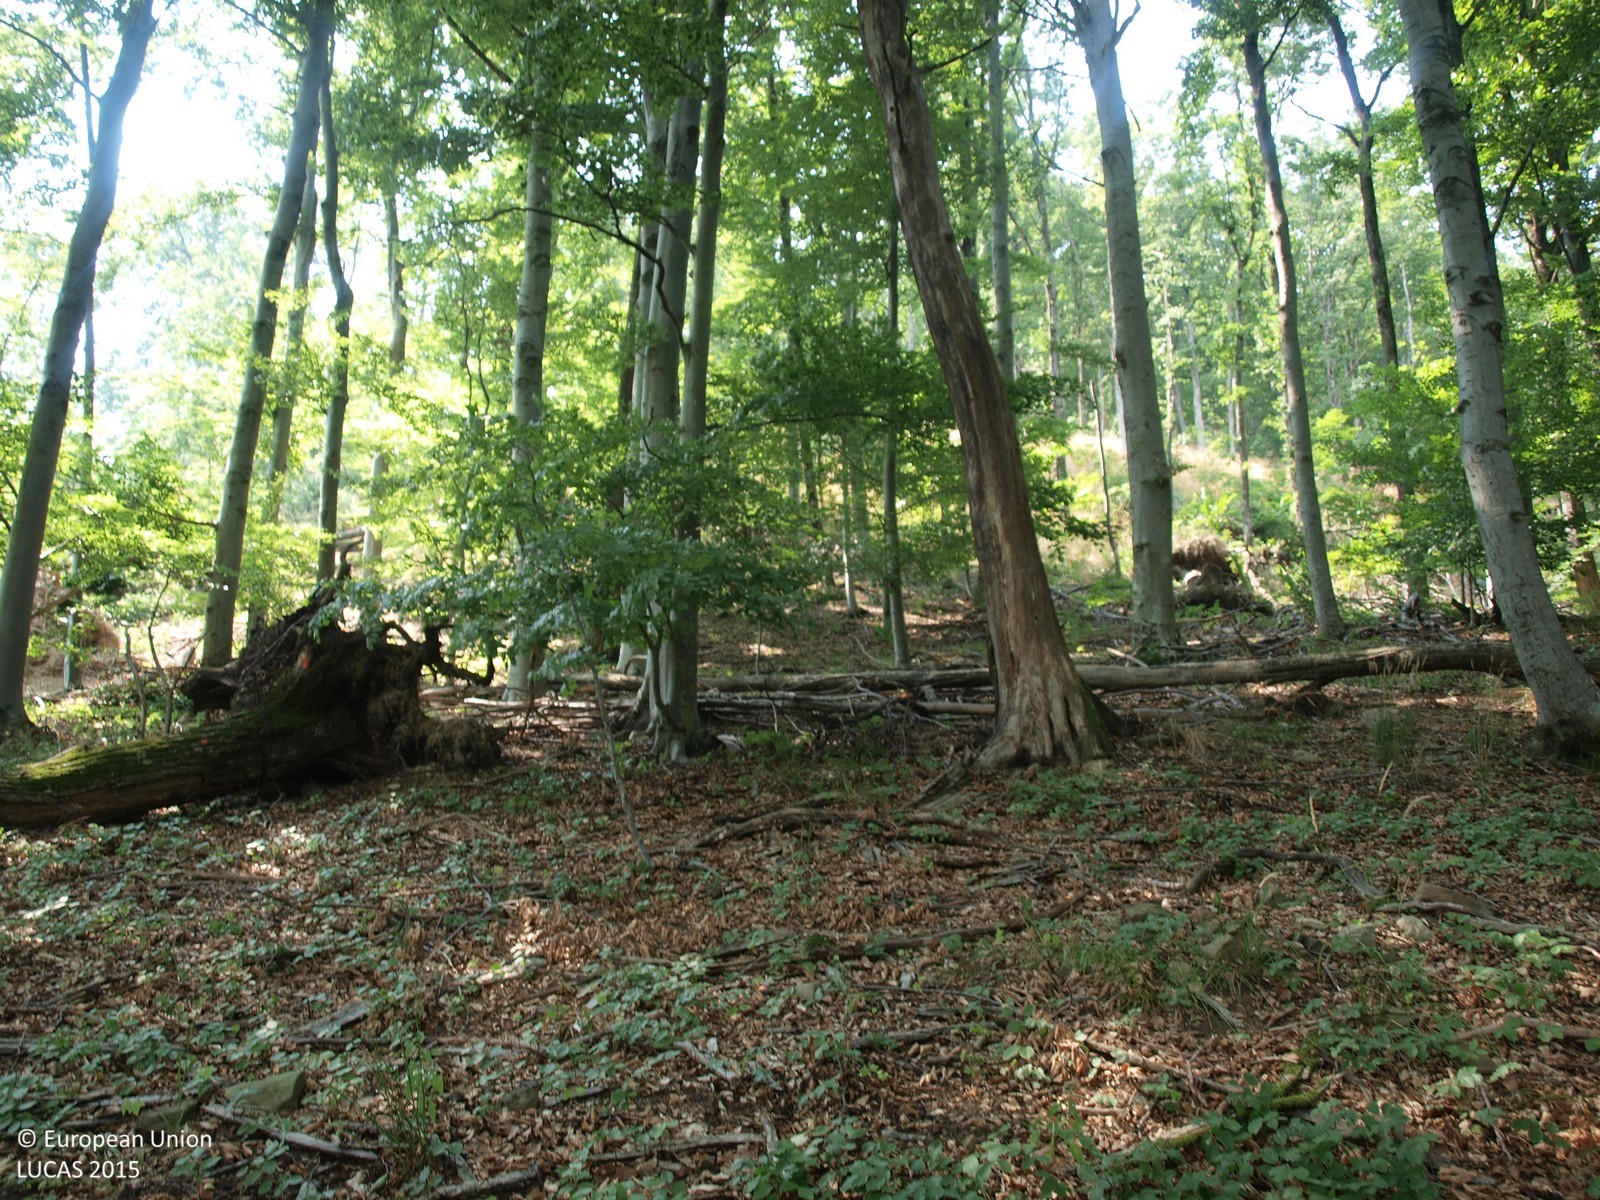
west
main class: Woodland
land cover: Broadleaved woodland
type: beech forest
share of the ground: > 75 %
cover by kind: broadleaved forest trees 100 %
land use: Forestry
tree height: > 5 m
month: August
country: HR
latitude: 45.8792
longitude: 15.9377
